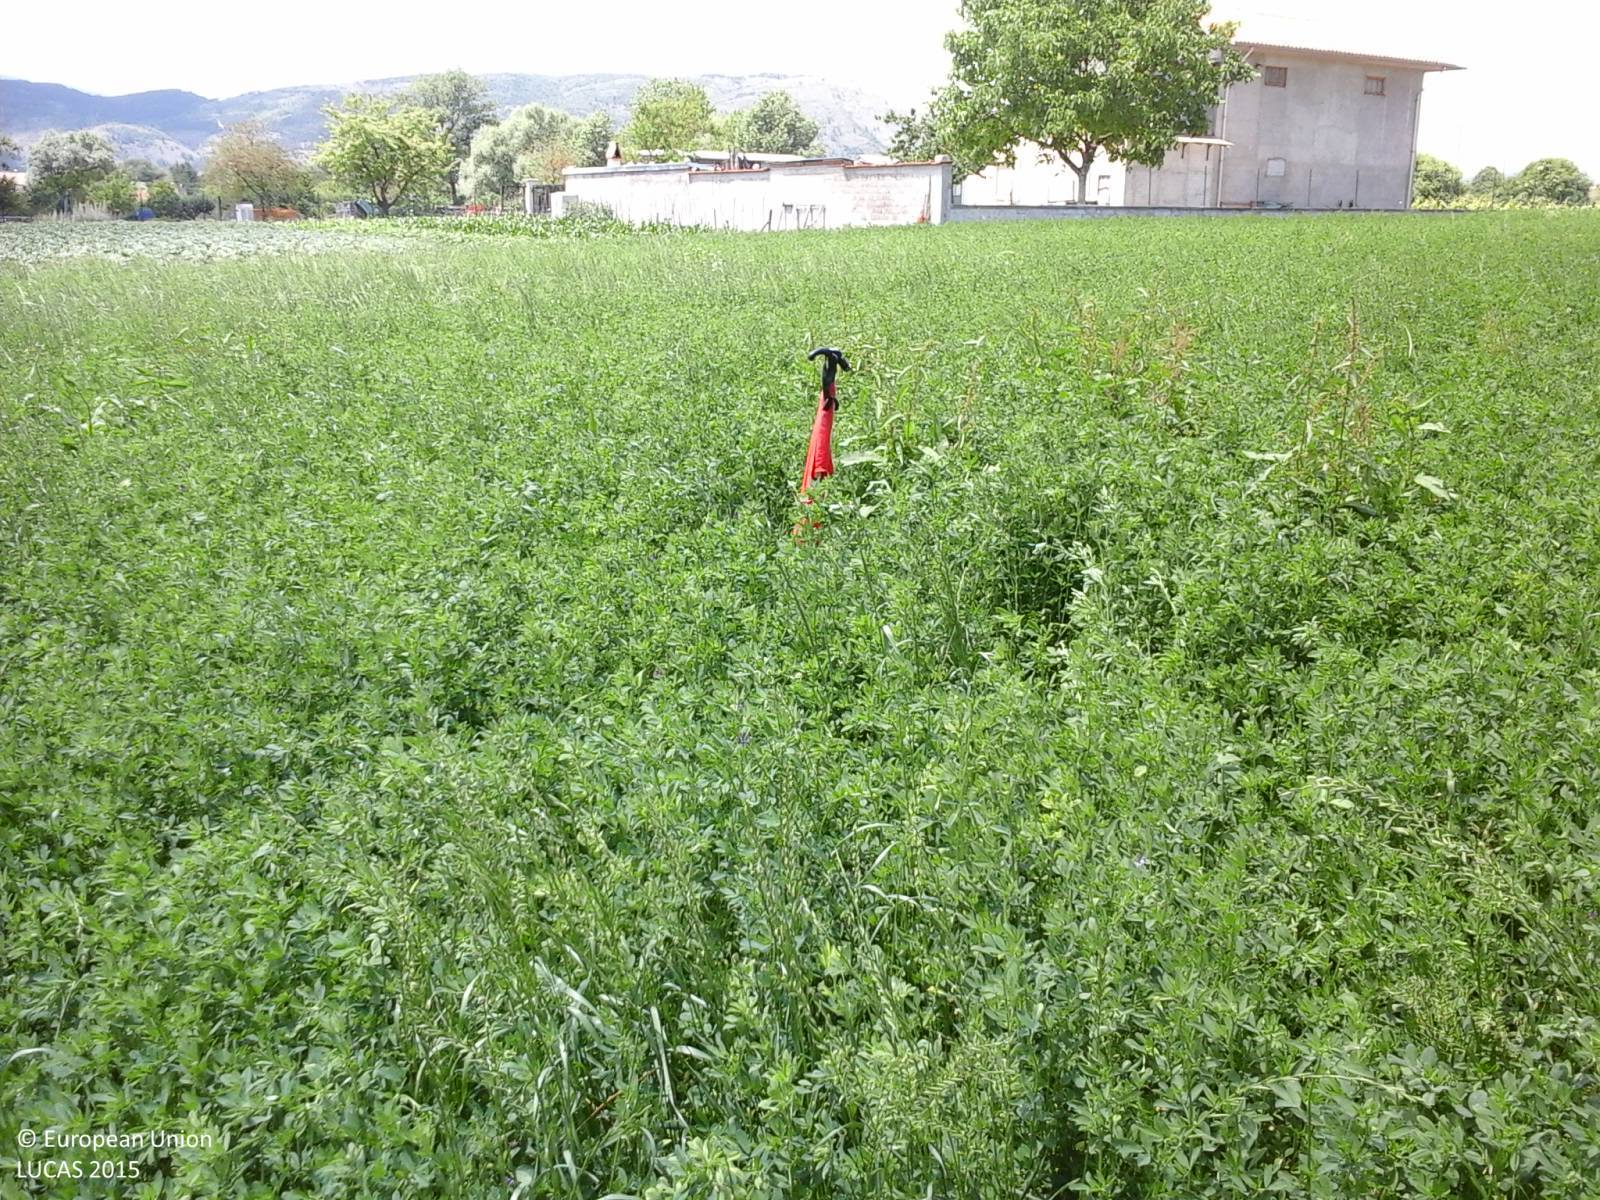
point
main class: Cropland
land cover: Lucerne
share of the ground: > 75 %
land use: Agriculture (excluding fallow land and kitchen gardens)
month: June
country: IT
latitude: 42.0346
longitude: 13.4549
